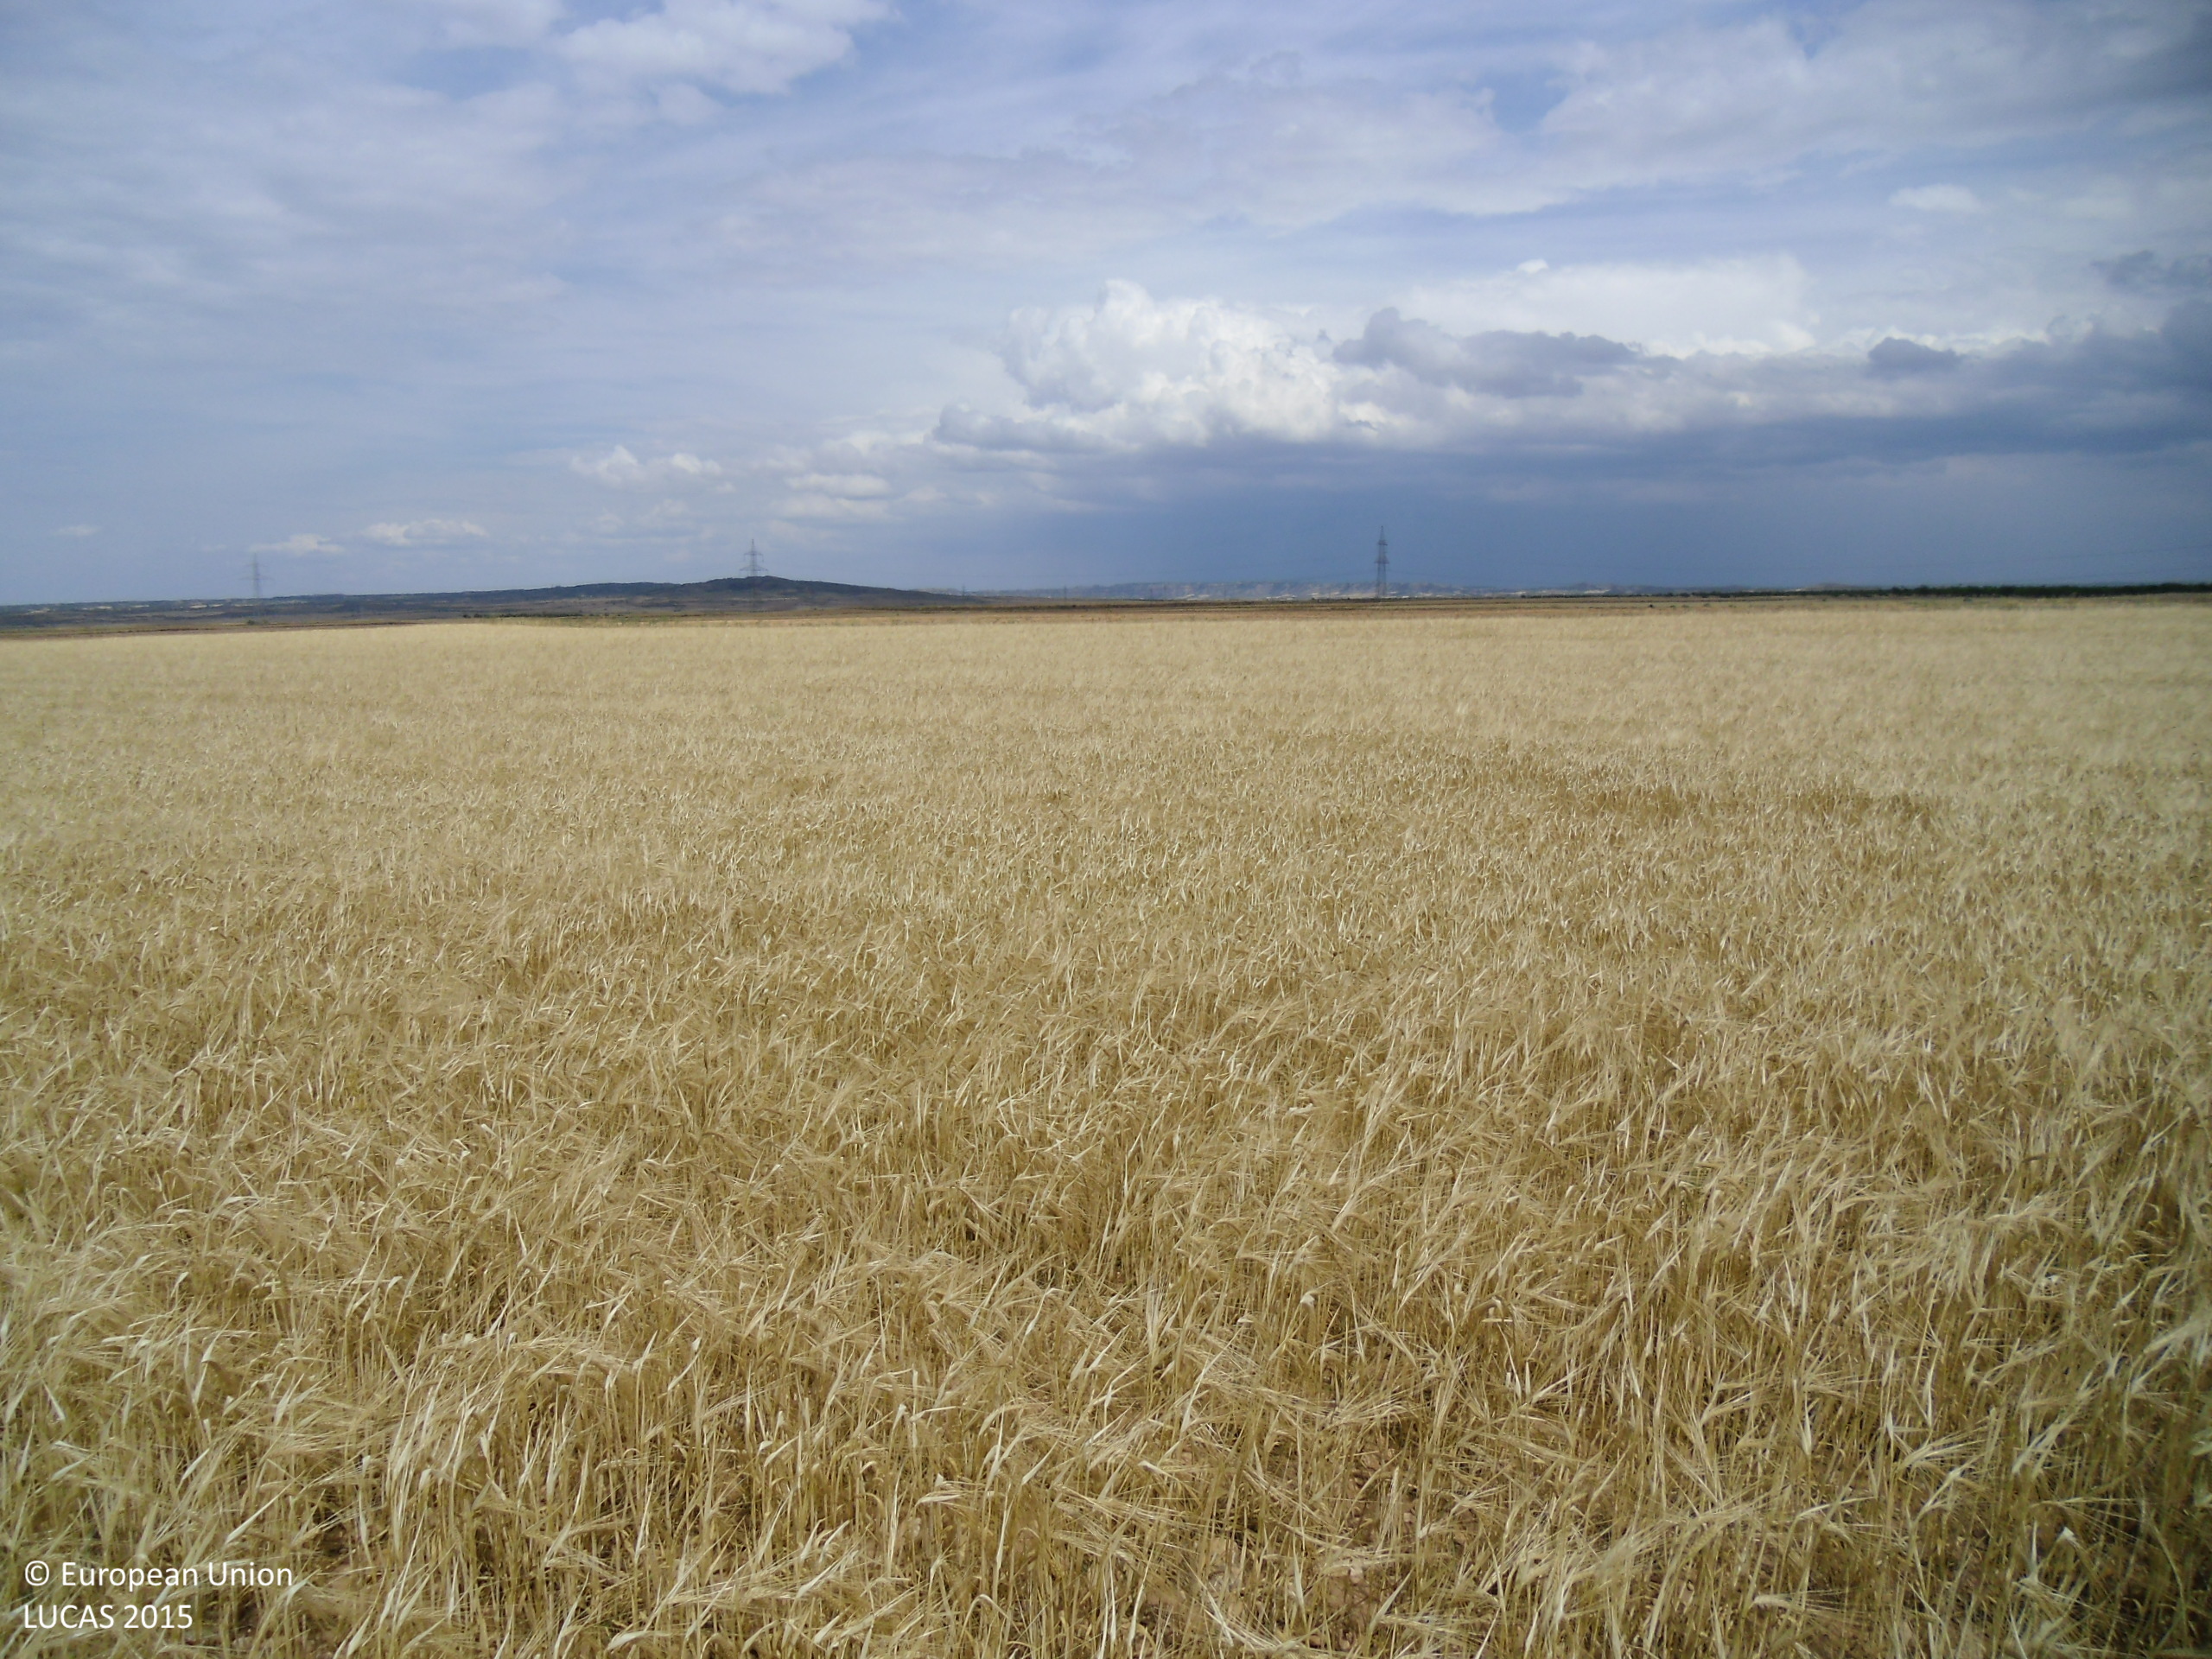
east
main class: Cropland
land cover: Rye
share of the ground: > 75 %
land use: Agriculture (excluding fallow land and kitchen gardens)
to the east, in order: Rye; Grass margins; Other bare soil; Grass margins; Other bare soil
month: June
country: ES
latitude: 41.1224
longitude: -0.3397
